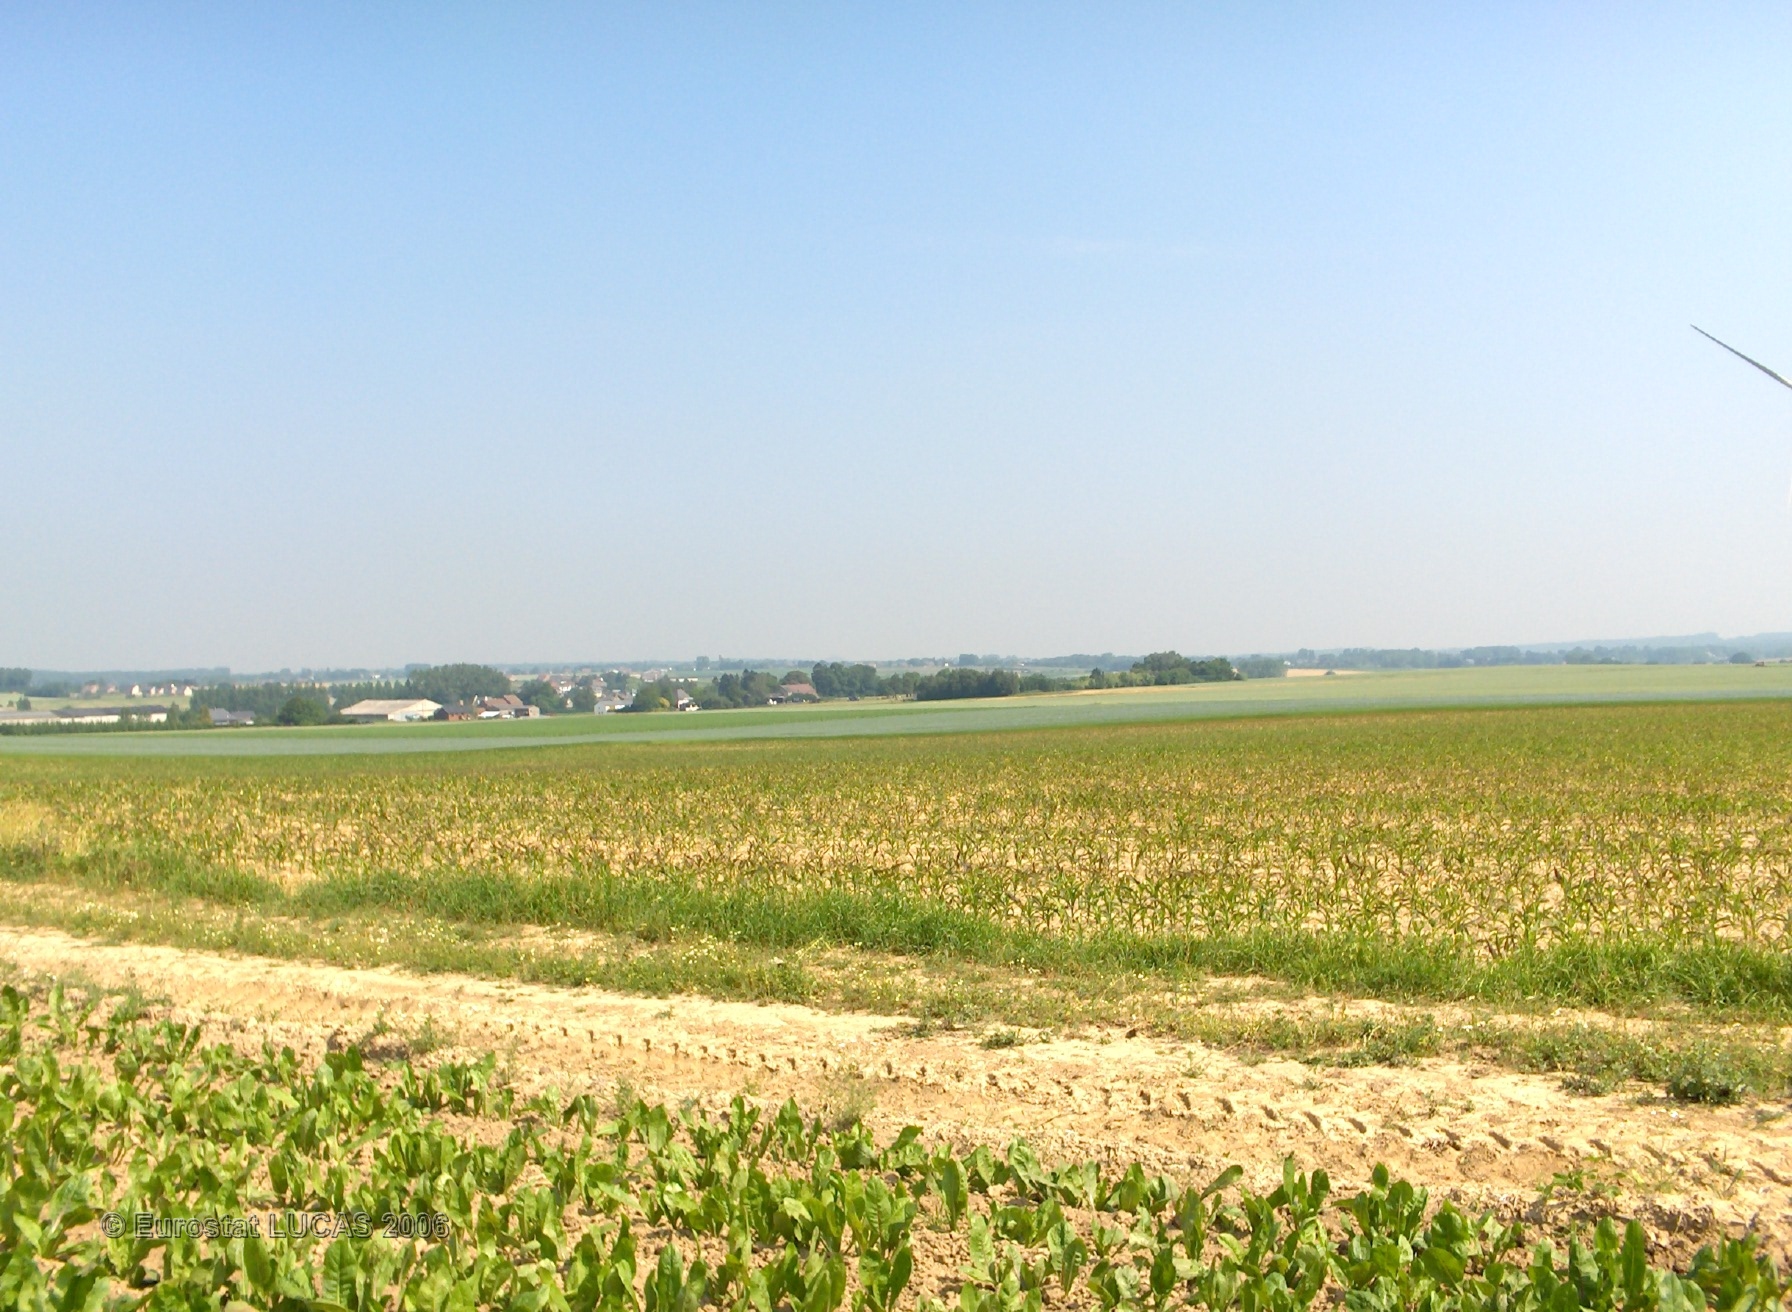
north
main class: Cropland
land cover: Other non-permanent industrial crops
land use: Agriculture (excluding fallow land and kitchen gardens)
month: June
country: BE
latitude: 50.3042
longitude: 4.5062
